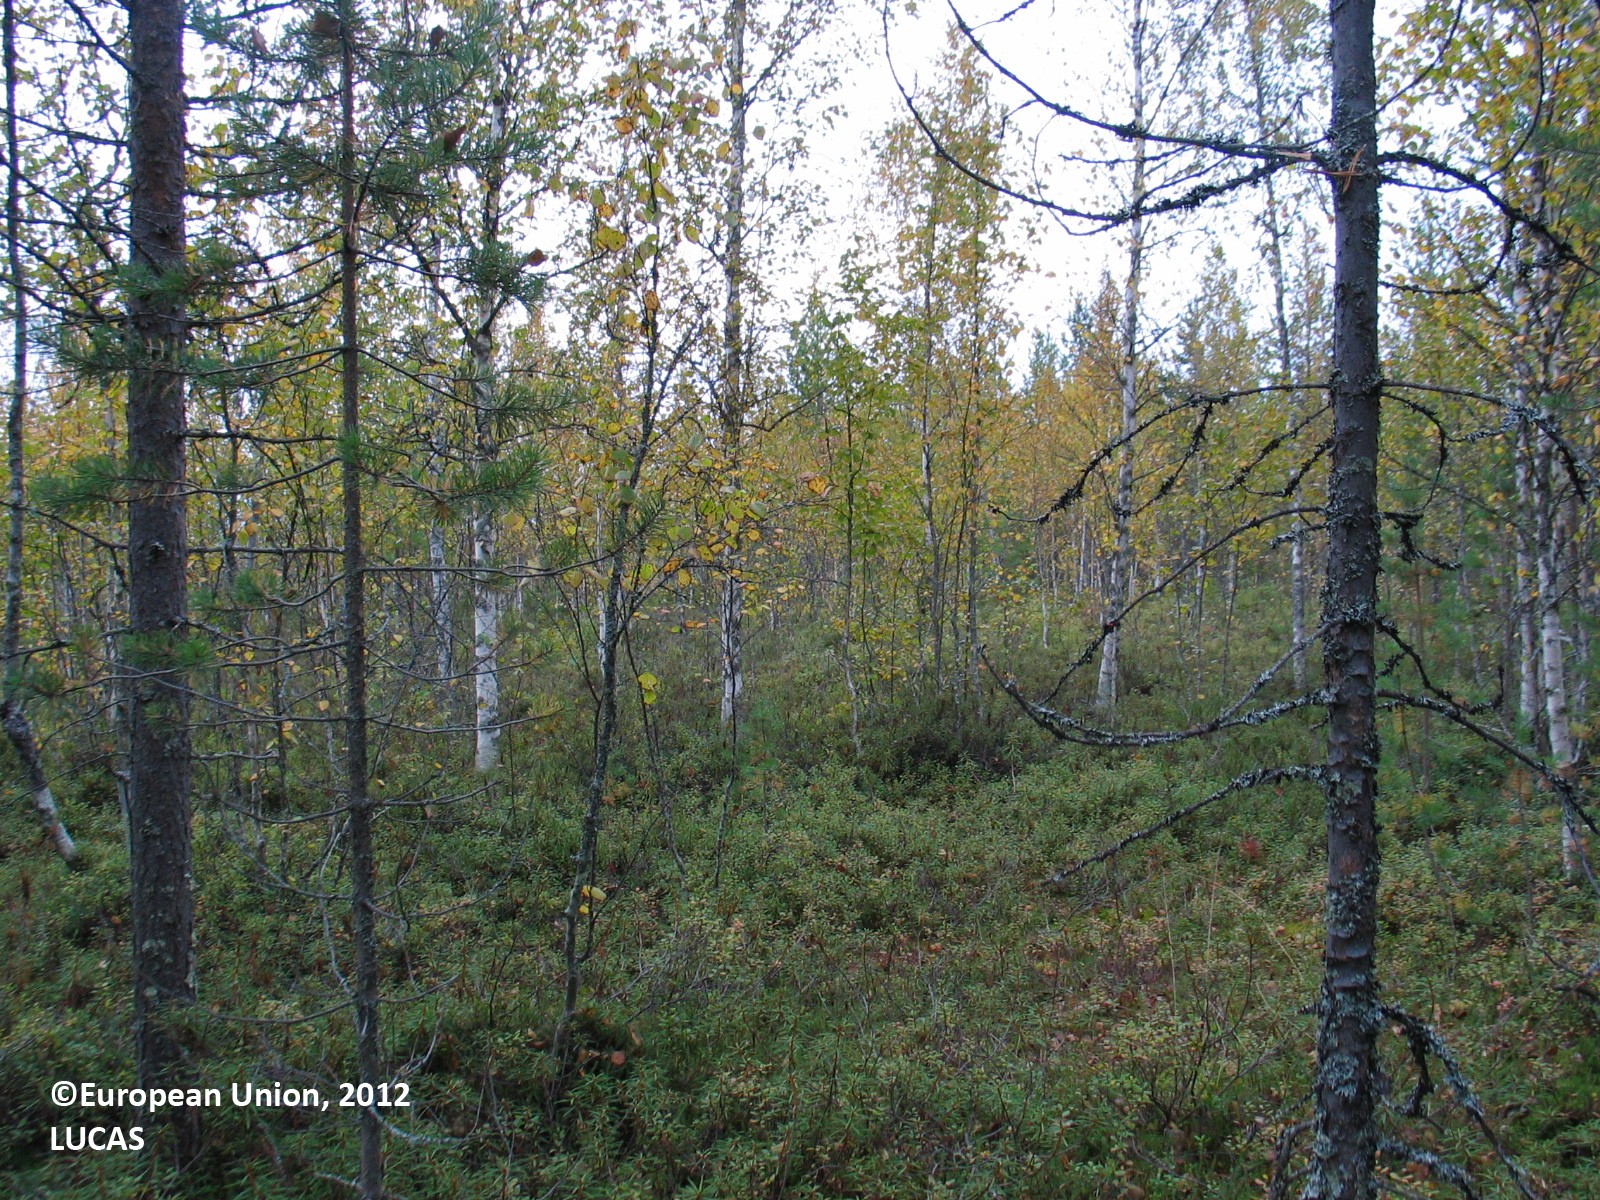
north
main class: Woodland
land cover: Other mixed woodland
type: boreal forest
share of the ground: 50 - 75 %
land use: Forestry
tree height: > 5 m
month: September
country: FI
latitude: 65.4795
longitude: 25.6948
